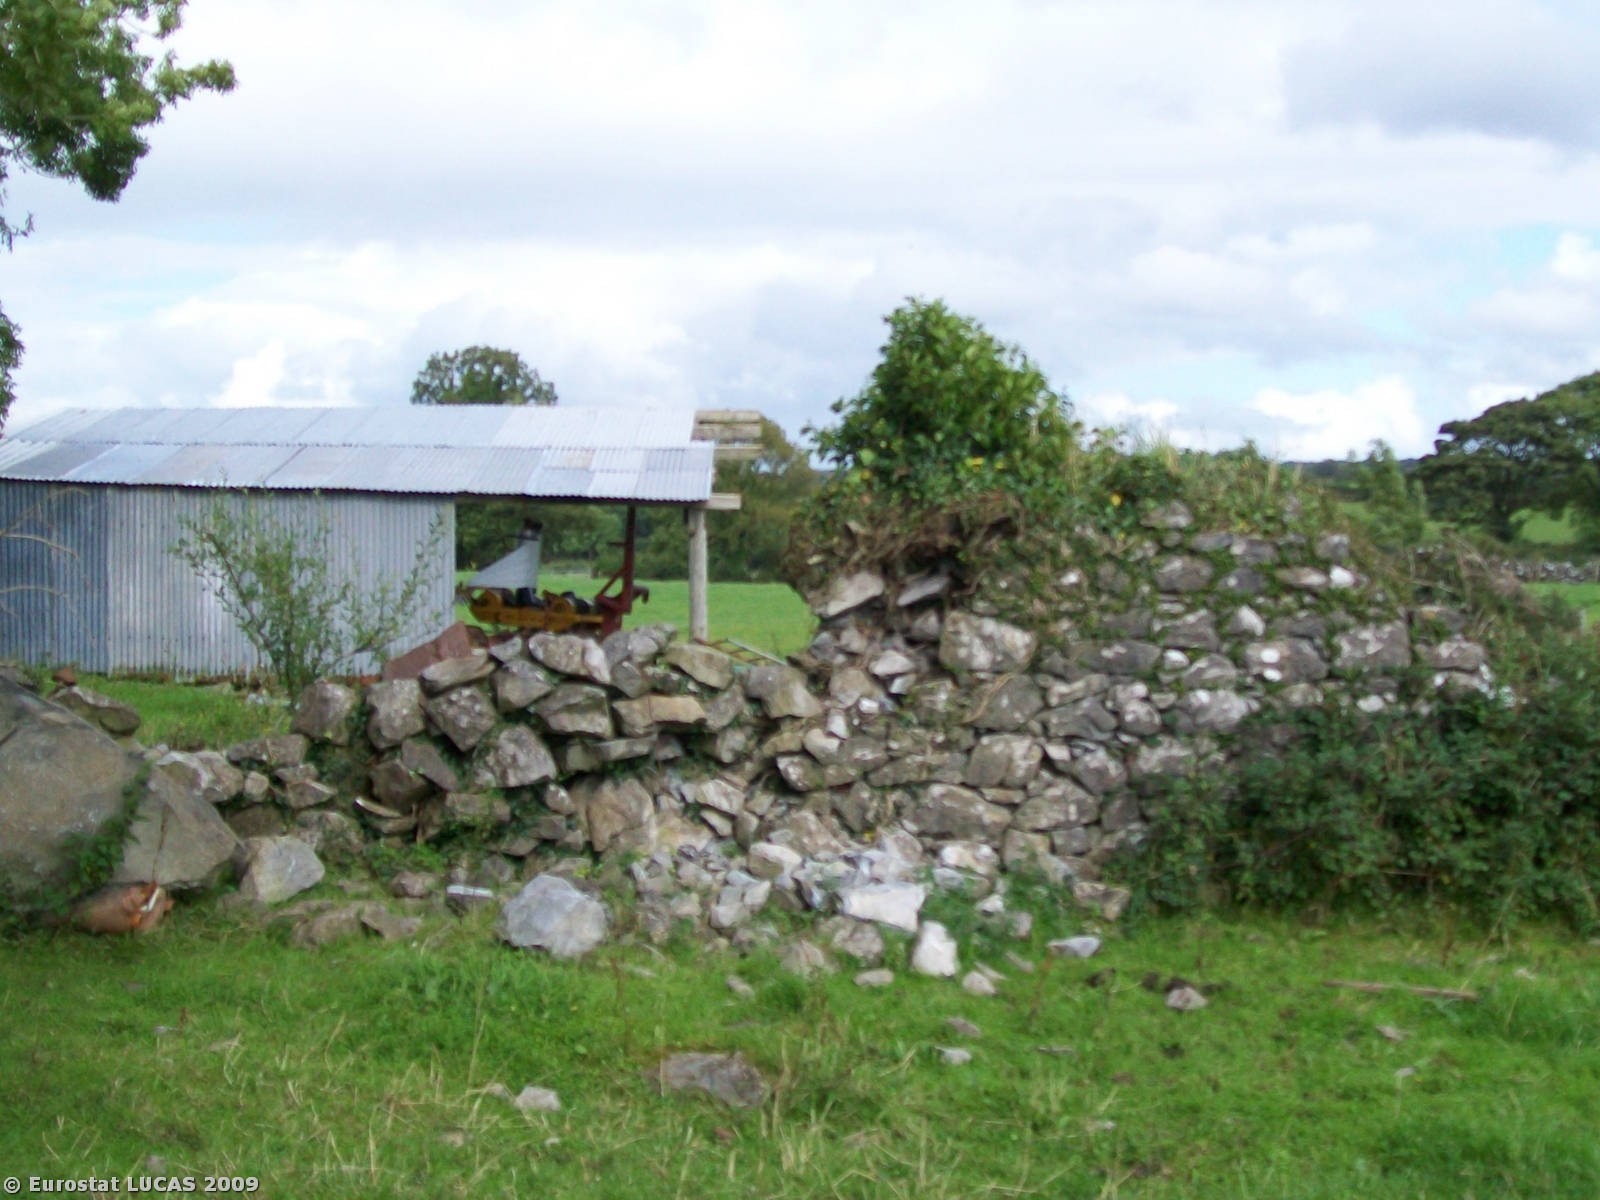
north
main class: Grassland
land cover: Grassland without tree/shrub cover
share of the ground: > 75 %
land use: Agriculture (excluding fallow land and kitchen gardens)
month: August
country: IE
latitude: 53.1200
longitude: -8.7461
